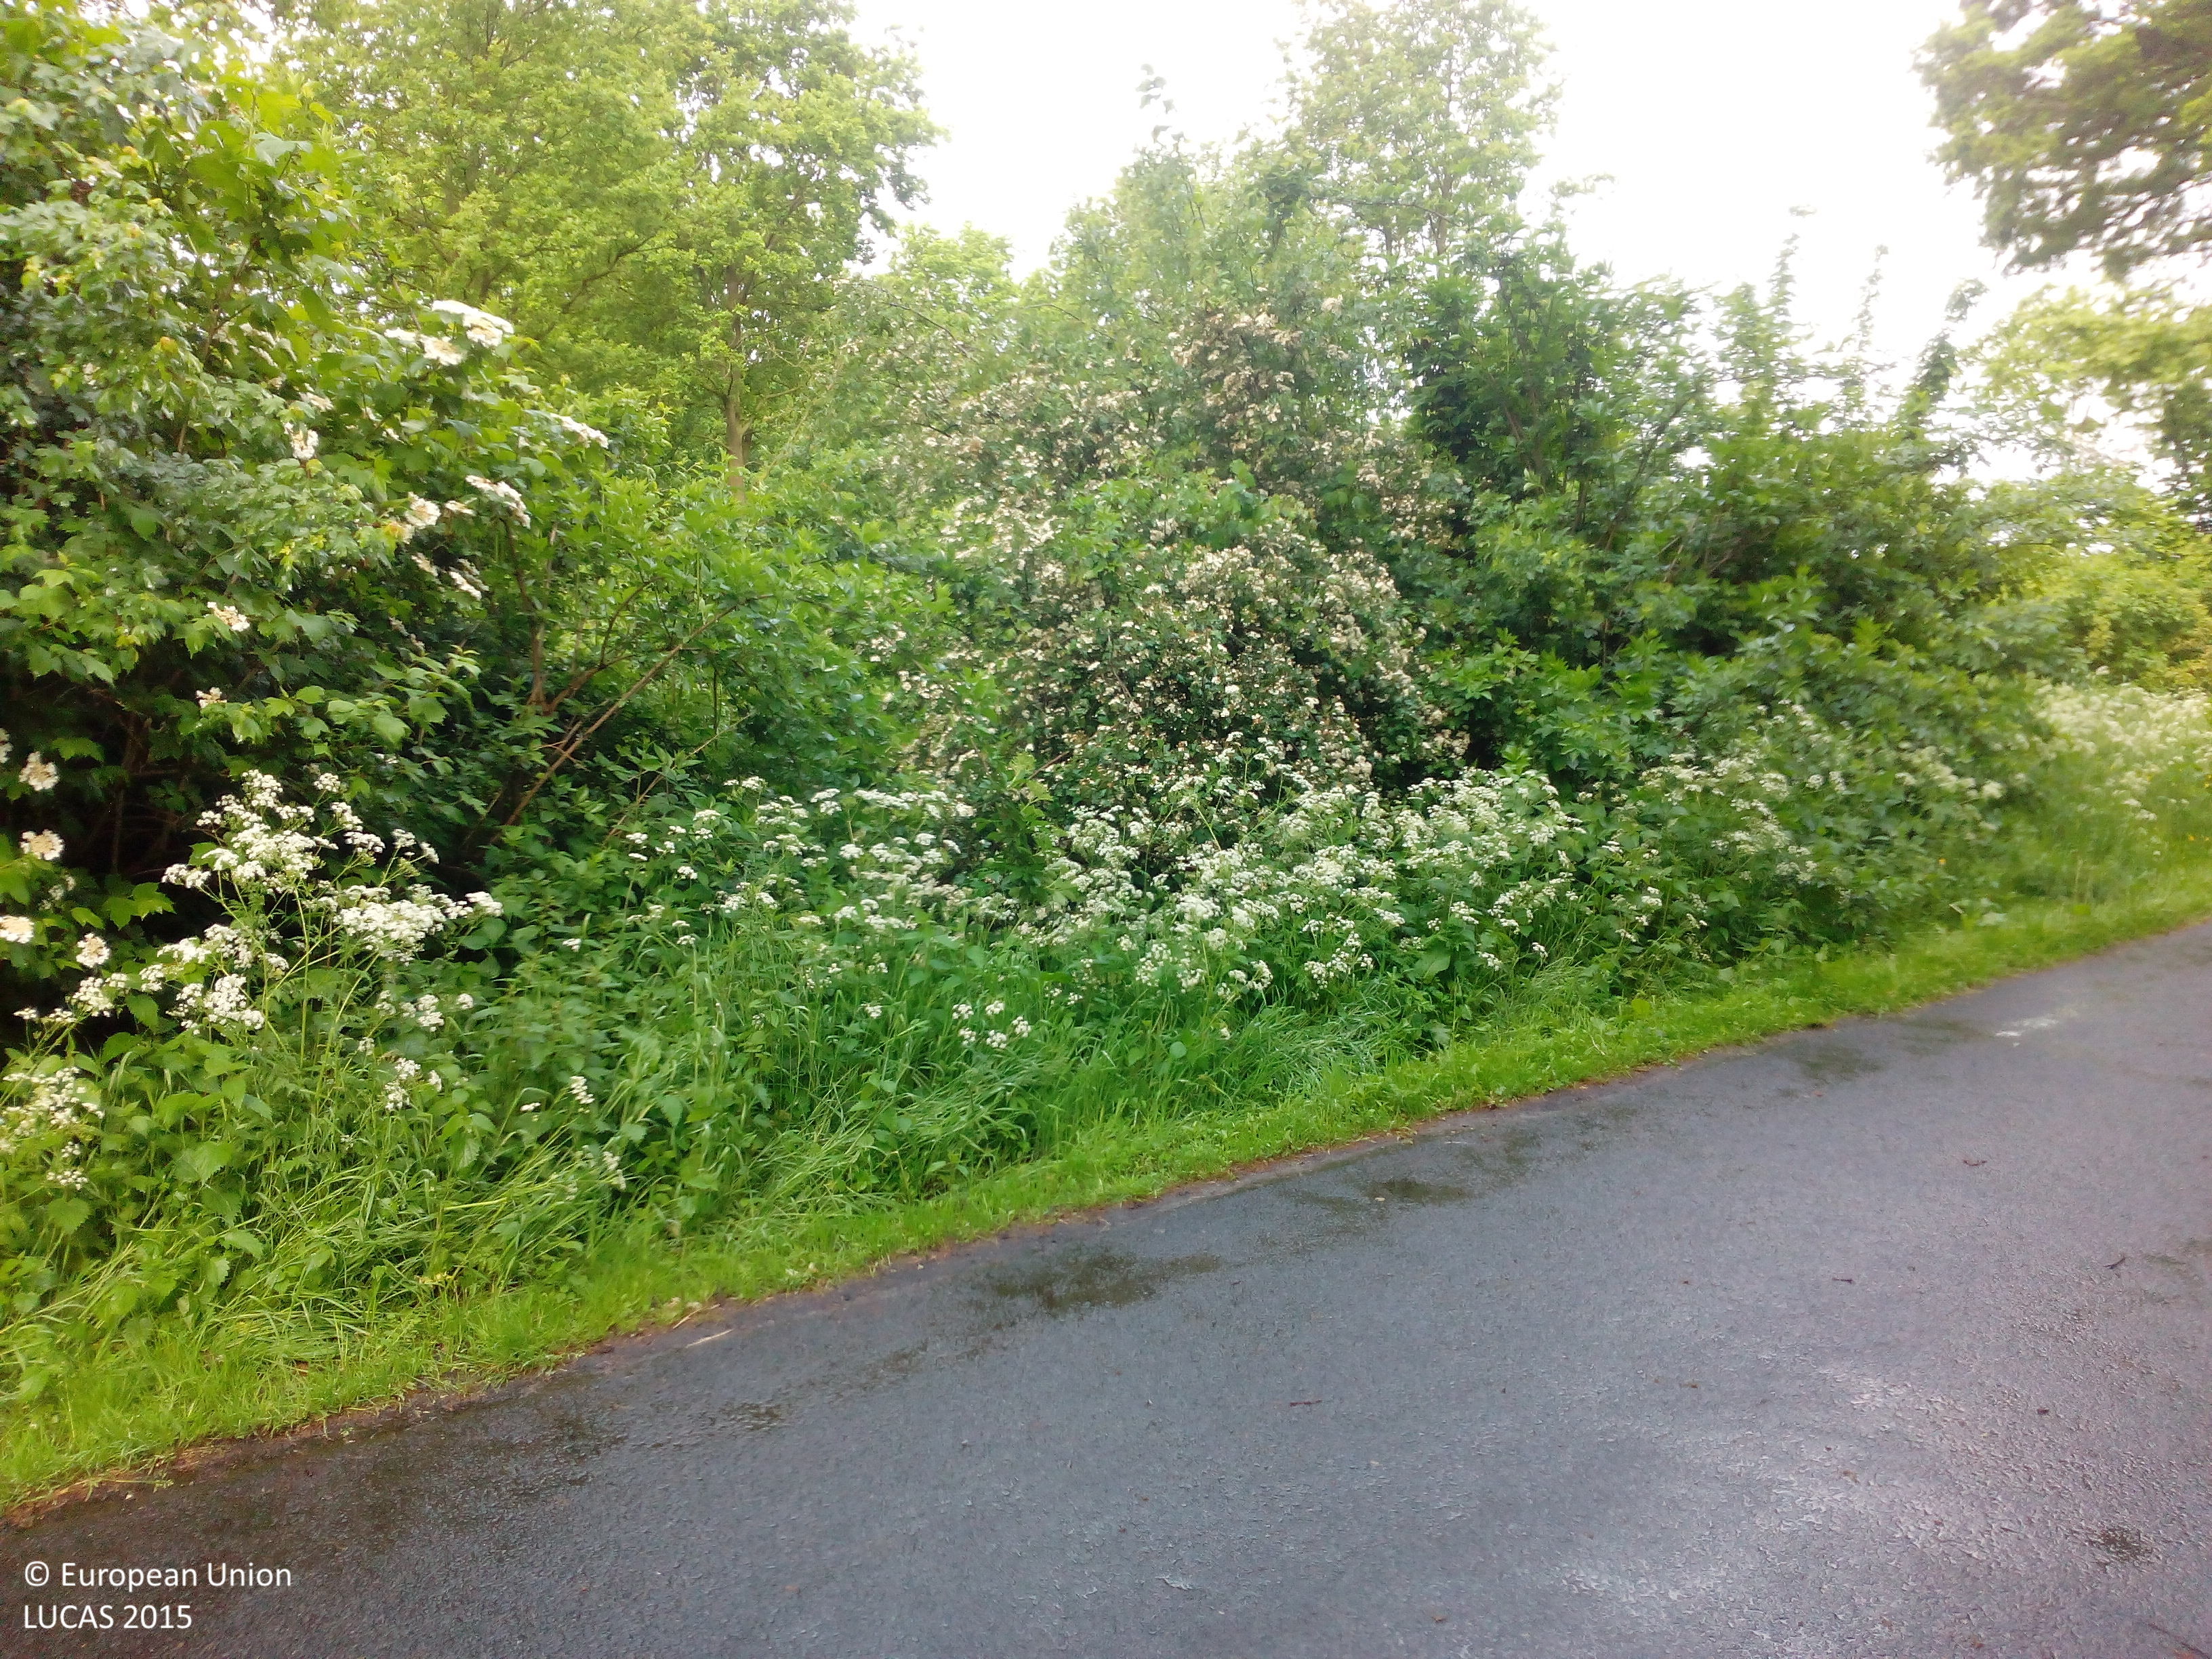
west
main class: Woodland
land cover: Broadleaved woodland
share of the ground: > 75 %
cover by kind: broadleaved forest trees 90 %, shrubs 10 %
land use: Road transport
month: May
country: NL
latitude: 52.2827
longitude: 6.2616
